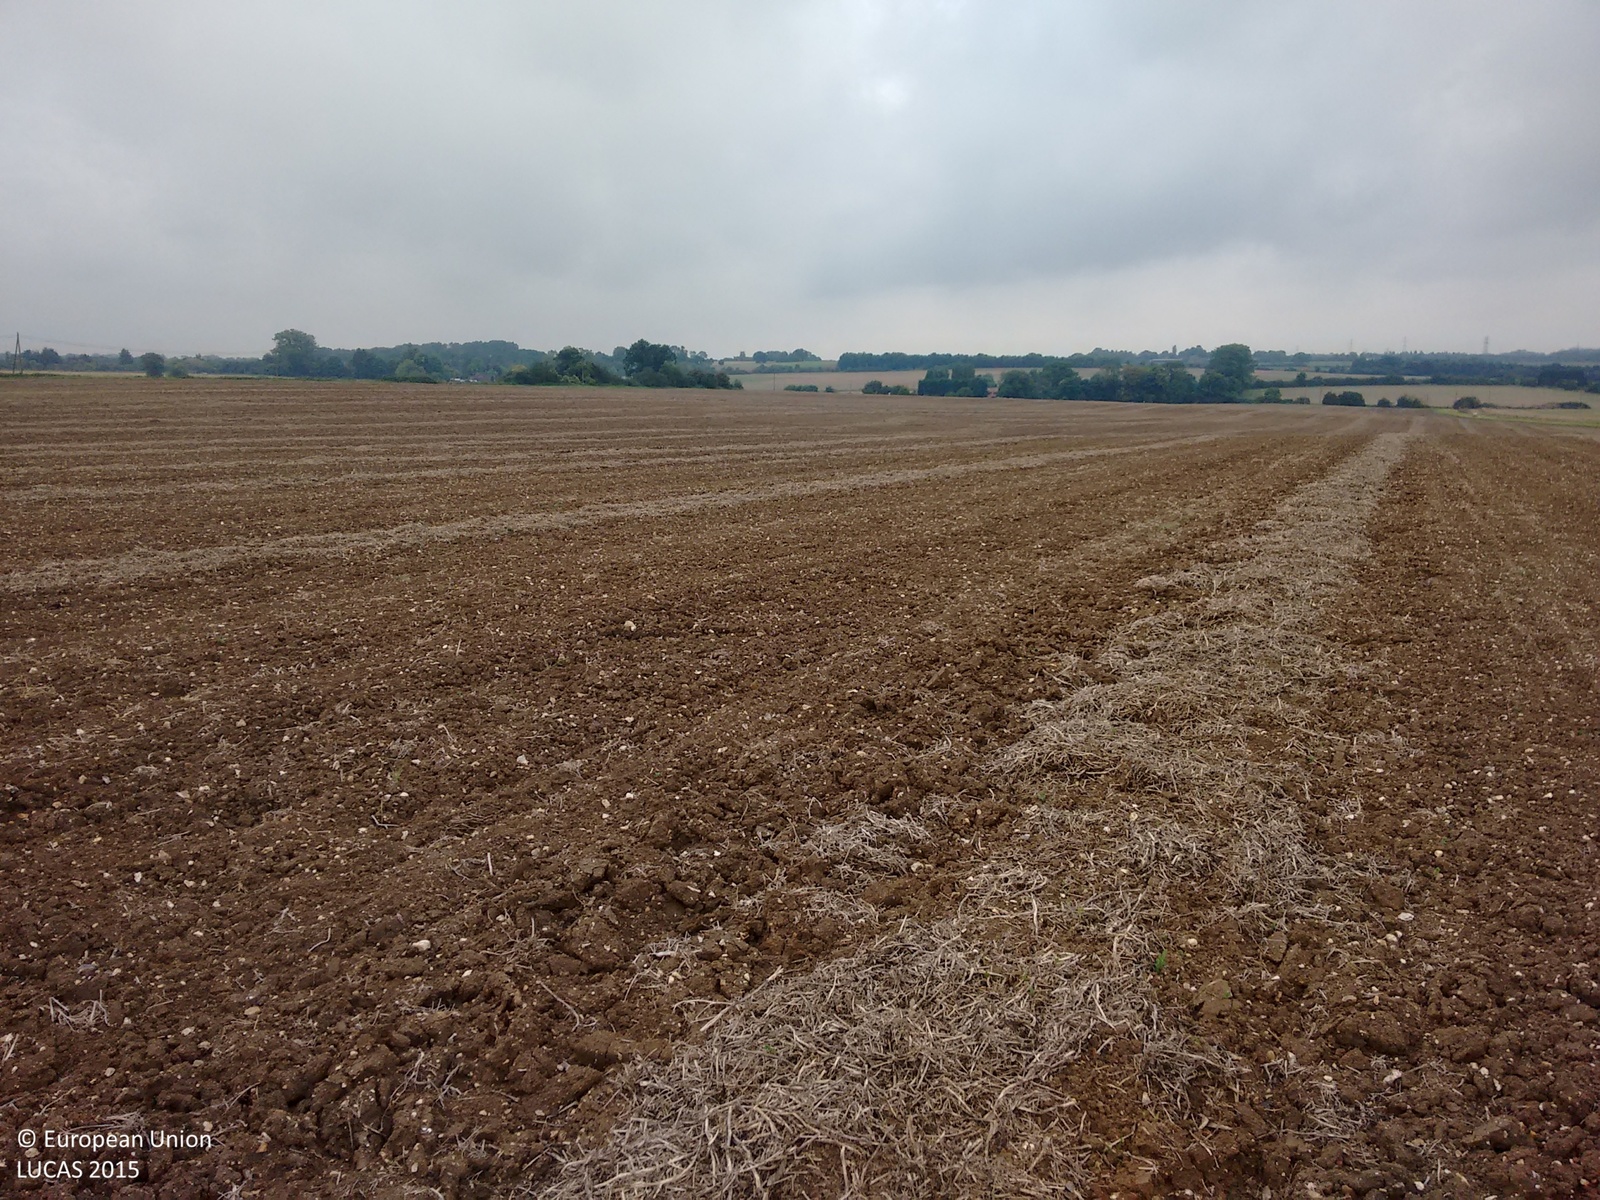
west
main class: Cropland
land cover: Dry pulses
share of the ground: < 10 %
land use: Agriculture (excluding fallow land and kitchen gardens)
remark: Harvested field
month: September
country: GB
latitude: 51.9381
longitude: 0.2386
